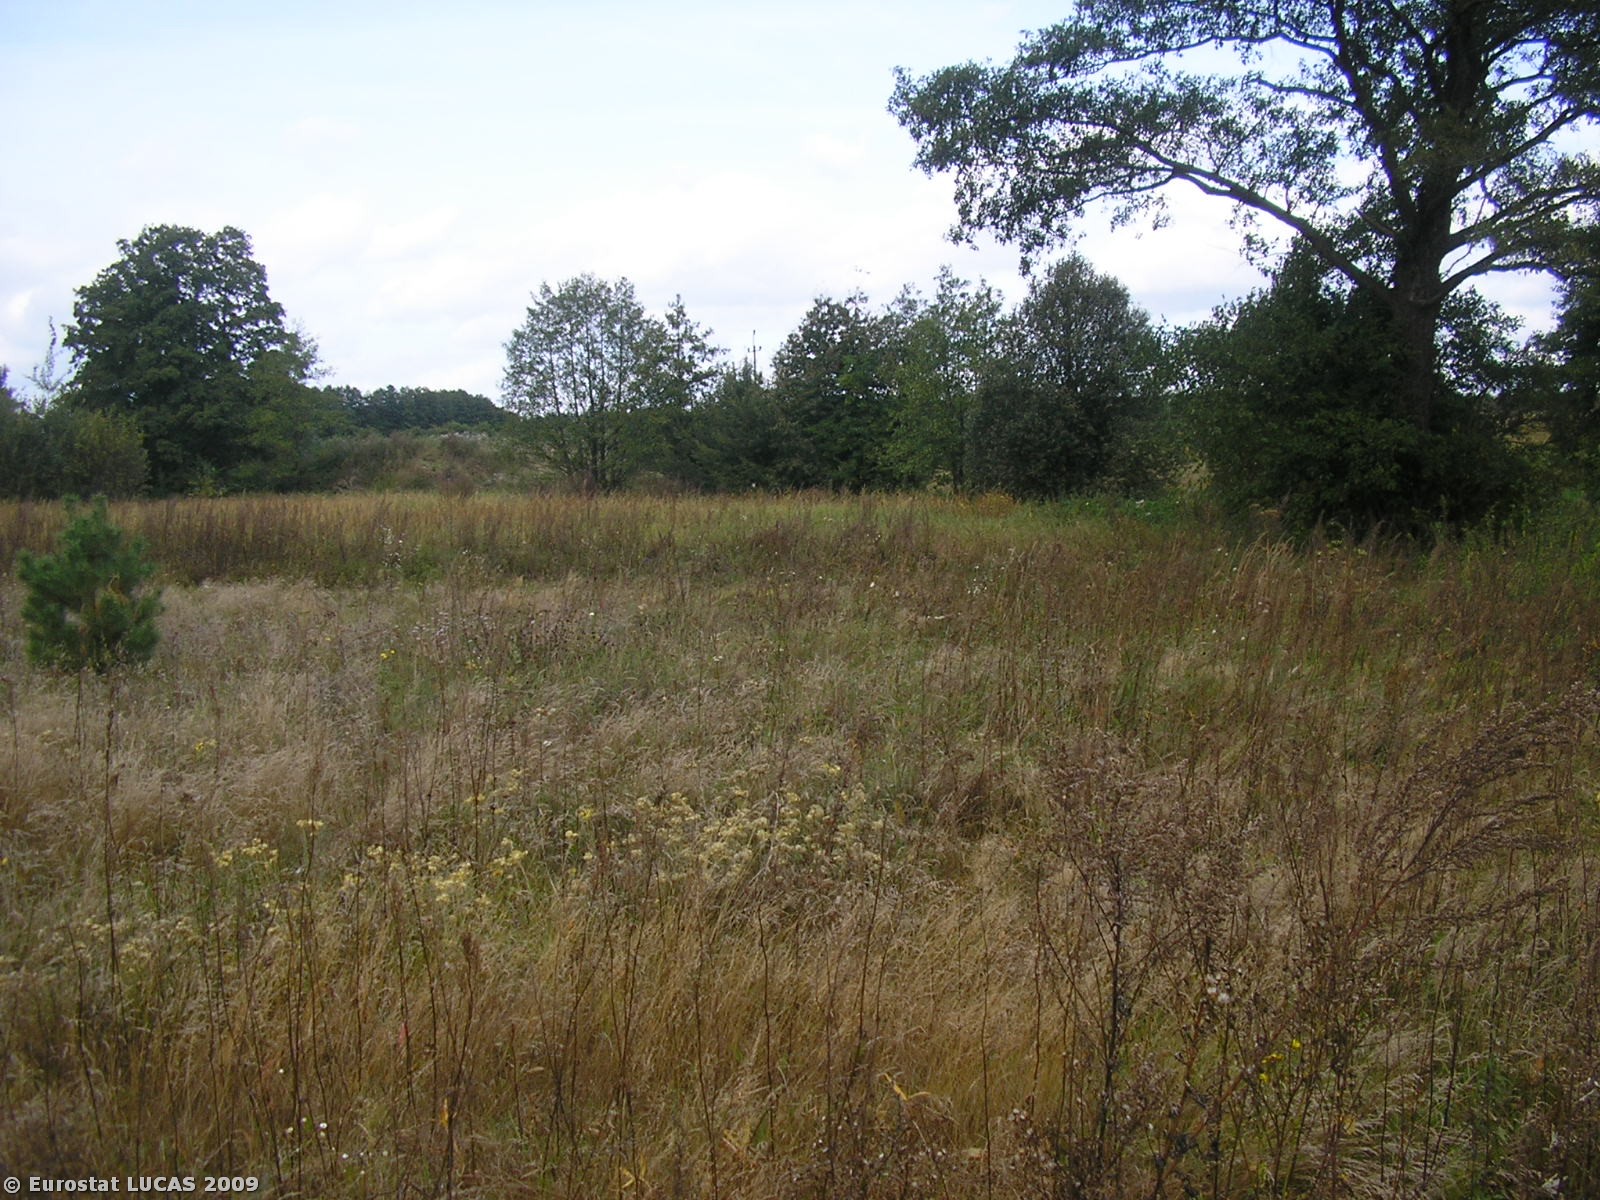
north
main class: Grassland
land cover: Grassland without tree/shrub cover
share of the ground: > 75 %
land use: Unused
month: September
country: PL
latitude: 51.6864
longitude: 20.9649
